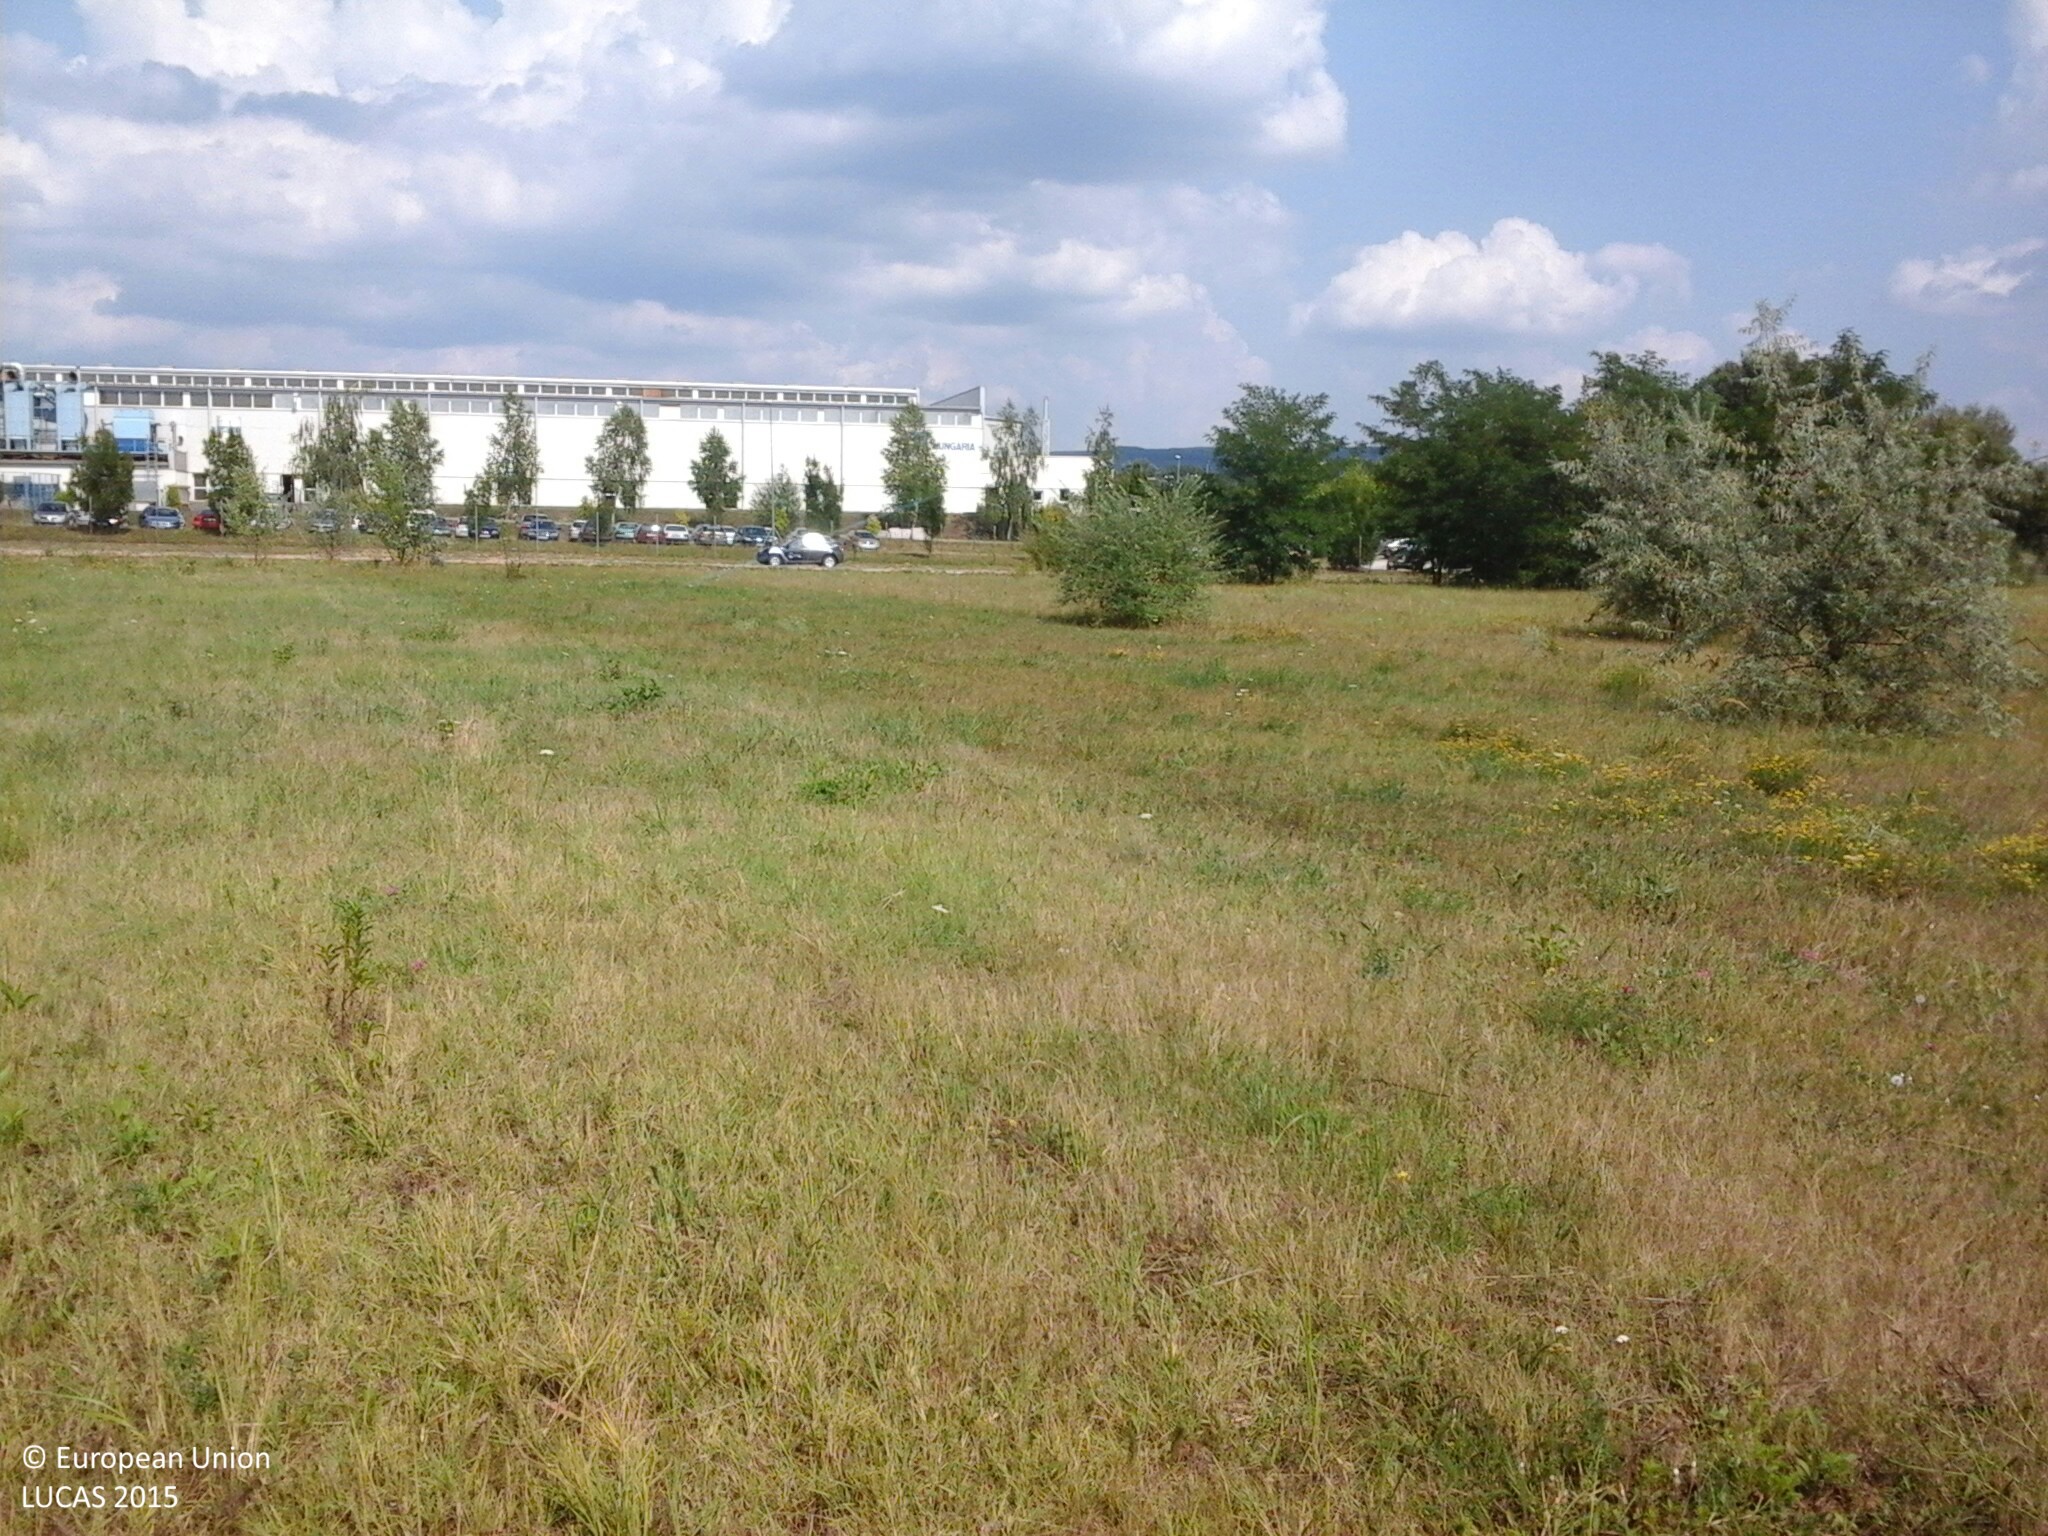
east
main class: Grassland
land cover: Grassland without tree/shrub cover
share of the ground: > 75 %
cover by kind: herbaceous plants 100 %
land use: Semi-natural and natural areas not in use
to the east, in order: Grassland without tree/shrub cover; Grassland with sparse tree/shrub cover; Grassland without tree/shrub cover; Ditches and canals; Paved roads, cycling and walking lanes; Ditches and canals; Grass margins; Artificial constructions in urban areas; Single bushes/trees; Grassland without tree/shrub cover
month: August
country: HU
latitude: 47.3763
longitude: 18.1831
